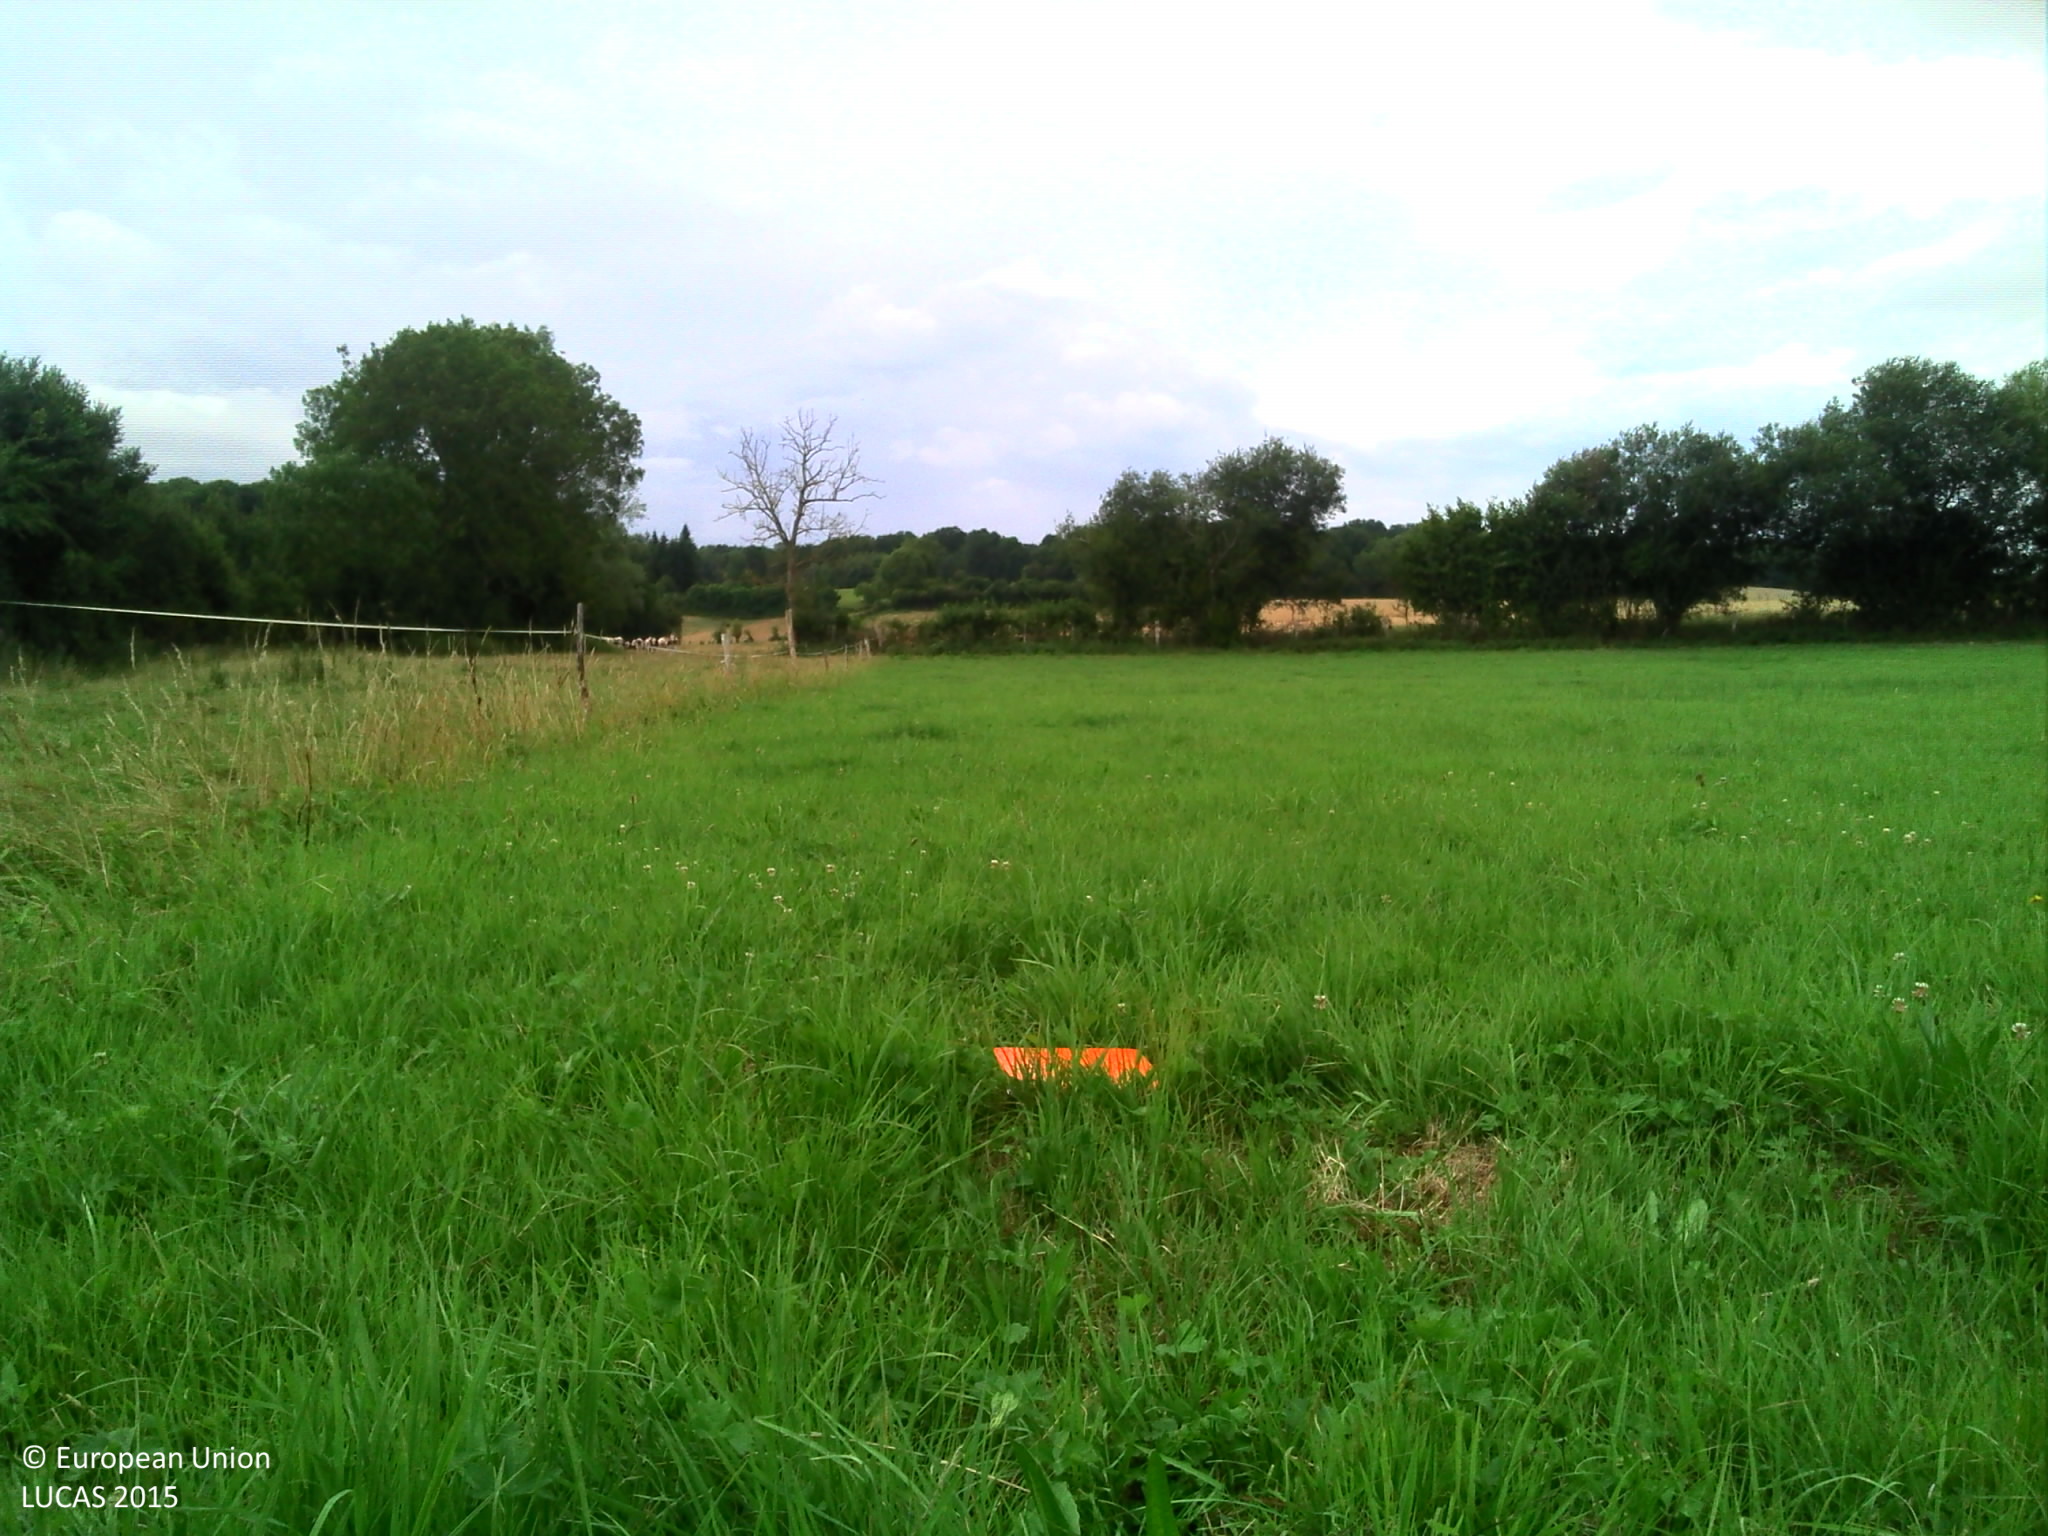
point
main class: Grassland
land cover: Grassland without tree/shrub cover
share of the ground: > 75 %
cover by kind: herbaceous plants 100 %
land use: Agriculture (excluding fallow land and kitchen gardens)
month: July
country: FR
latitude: 48.5711
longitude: 0.4743
